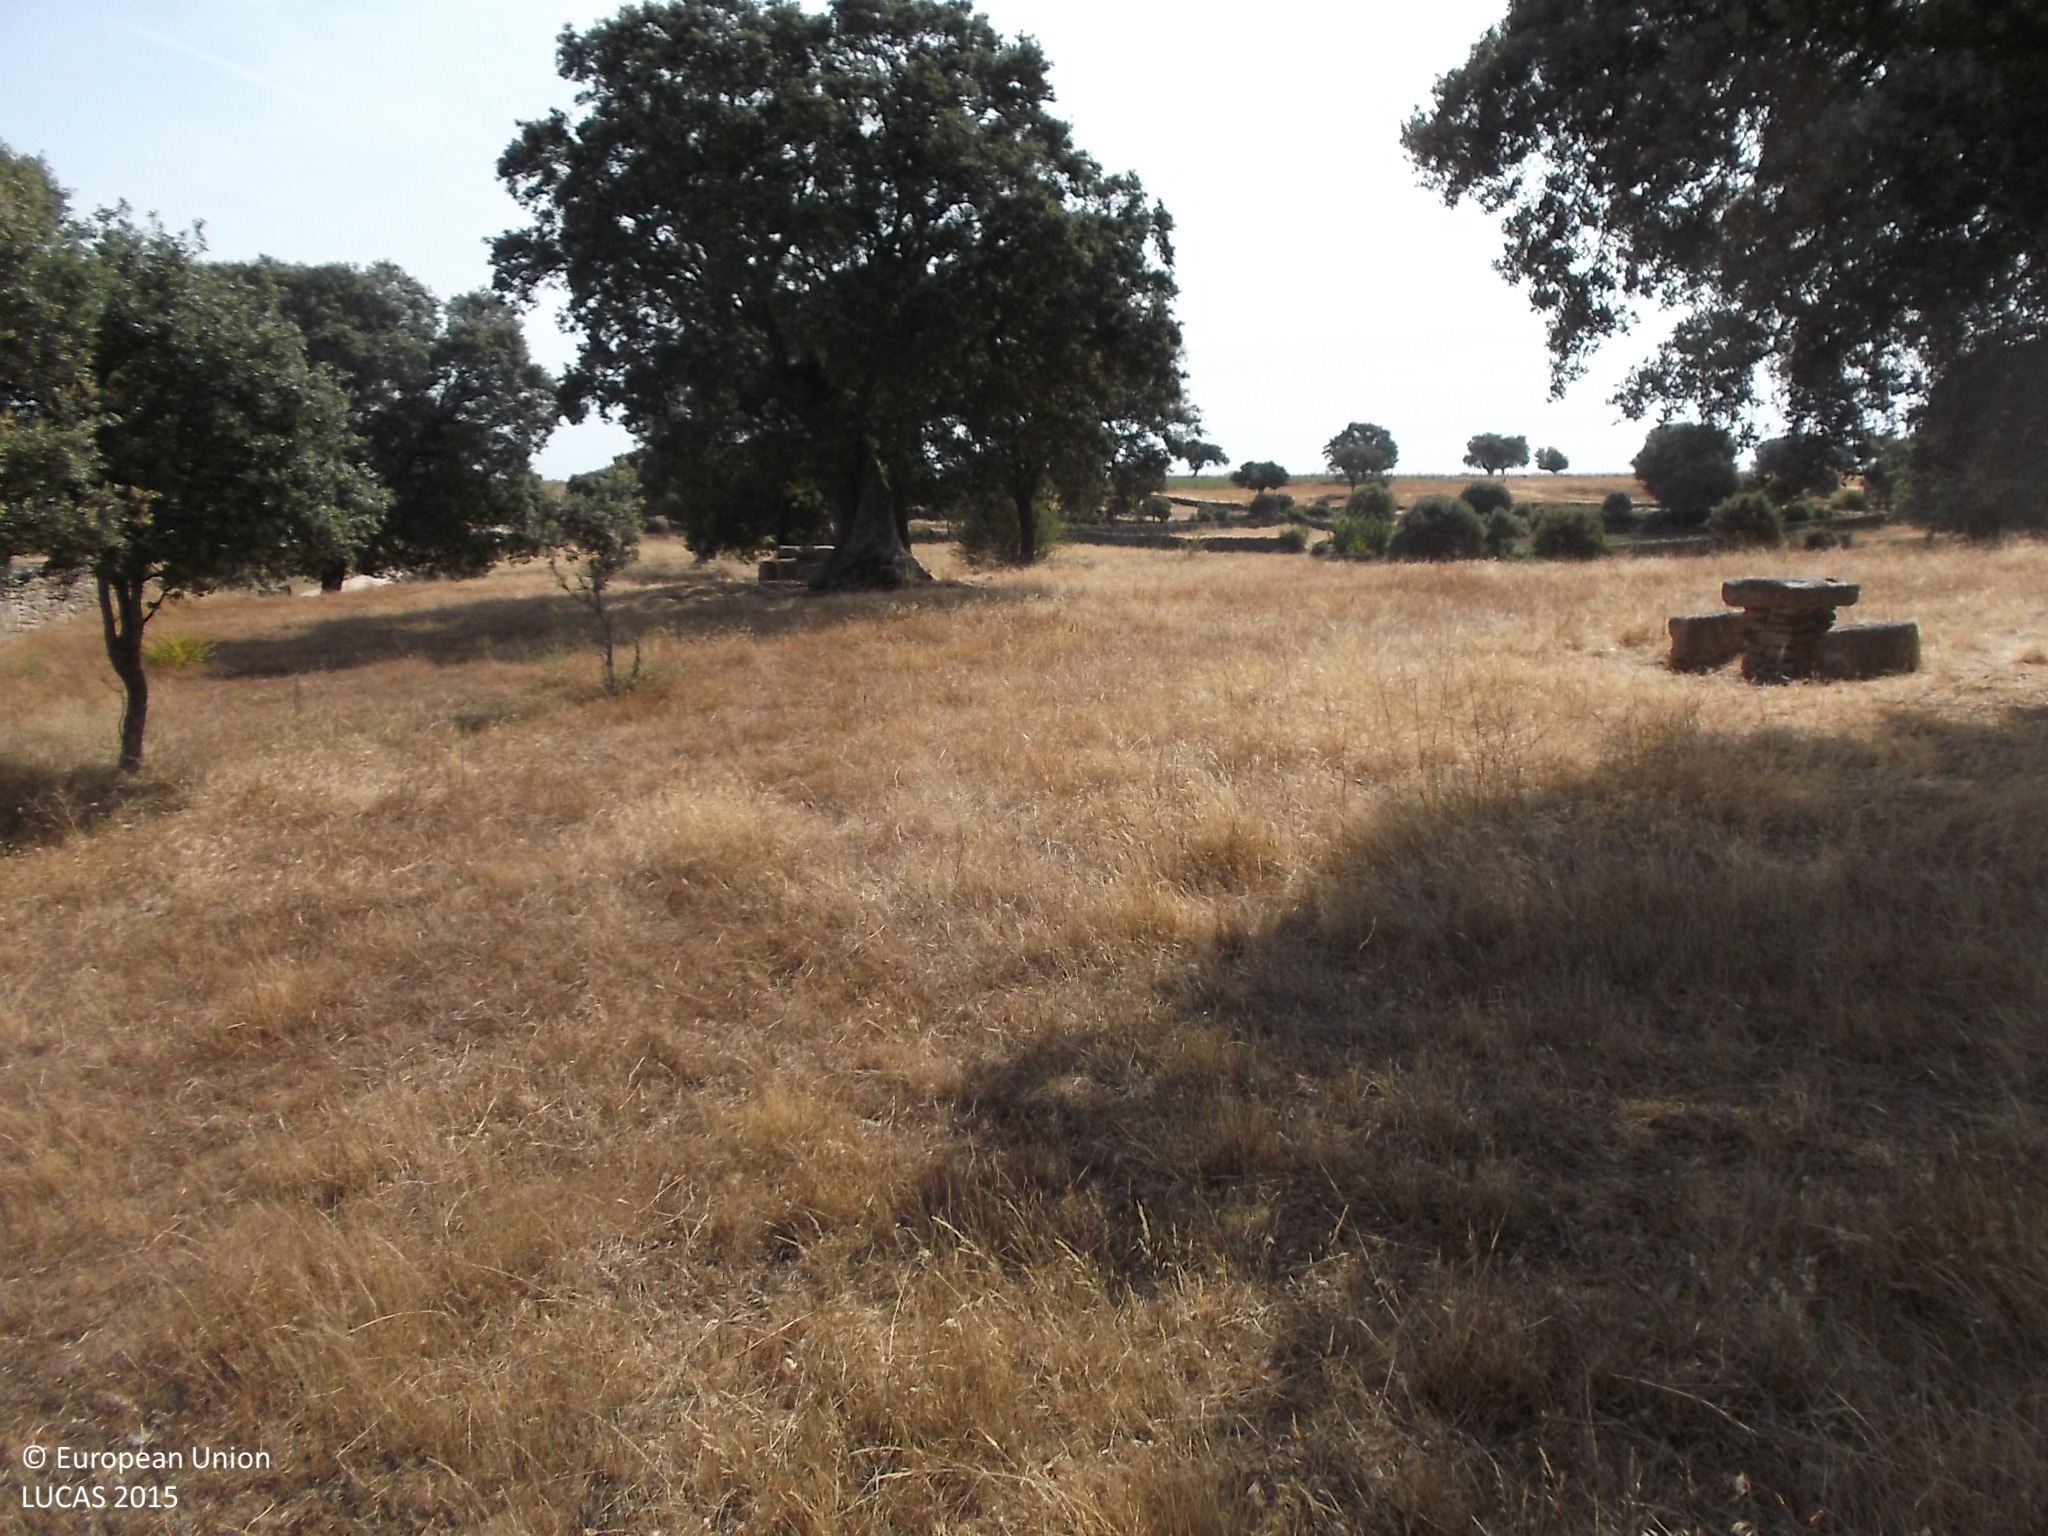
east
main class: Grassland
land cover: Grassland with sparse tree/shrub cover
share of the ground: > 75 %
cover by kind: herbaceous plants 90 %, broadleaved forest trees 5 %, shrubs 5 %
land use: Agriculture (excluding fallow land and kitchen gardens)
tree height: < 5 m
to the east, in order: Grassland with sparse tree/shrub cover; Grassland without tree/shrub cover; Dry stone walls; Other fresh vegetables; Shruby margins; Dry stone walls; Shruby margins; Grassland without tree/shrub cover; Shruby margins; Dry stone walls; Grassland without tree/shrub cover; Dry stone walls; Grassland without tree/shrub cover; Dry stone walls; Grass margins; Rye
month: July
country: ES
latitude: 41.1773
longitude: -6.5127
